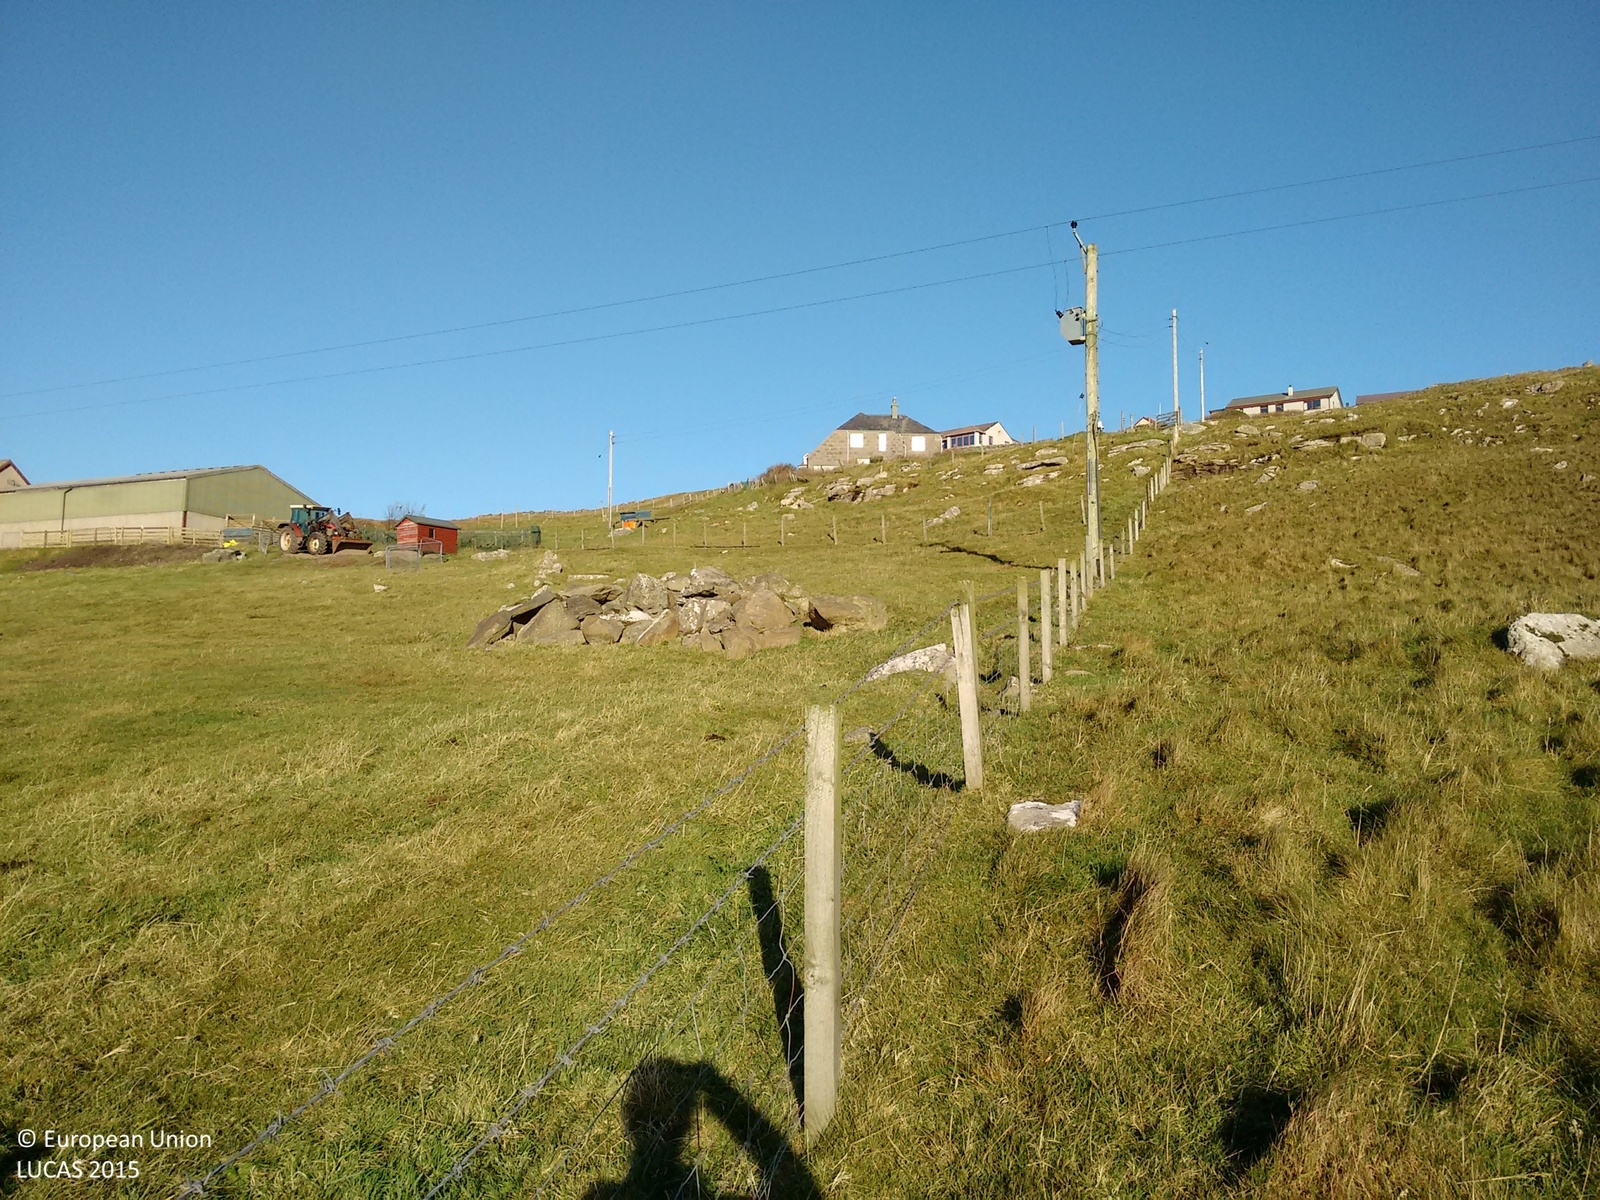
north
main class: Grassland
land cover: Grassland without tree/shrub cover
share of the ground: > 75 %
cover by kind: herbaceous plants 100 %
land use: Agriculture (excluding fallow land and kitchen gardens)
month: November
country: GB
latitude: 60.1338
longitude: -1.1990
